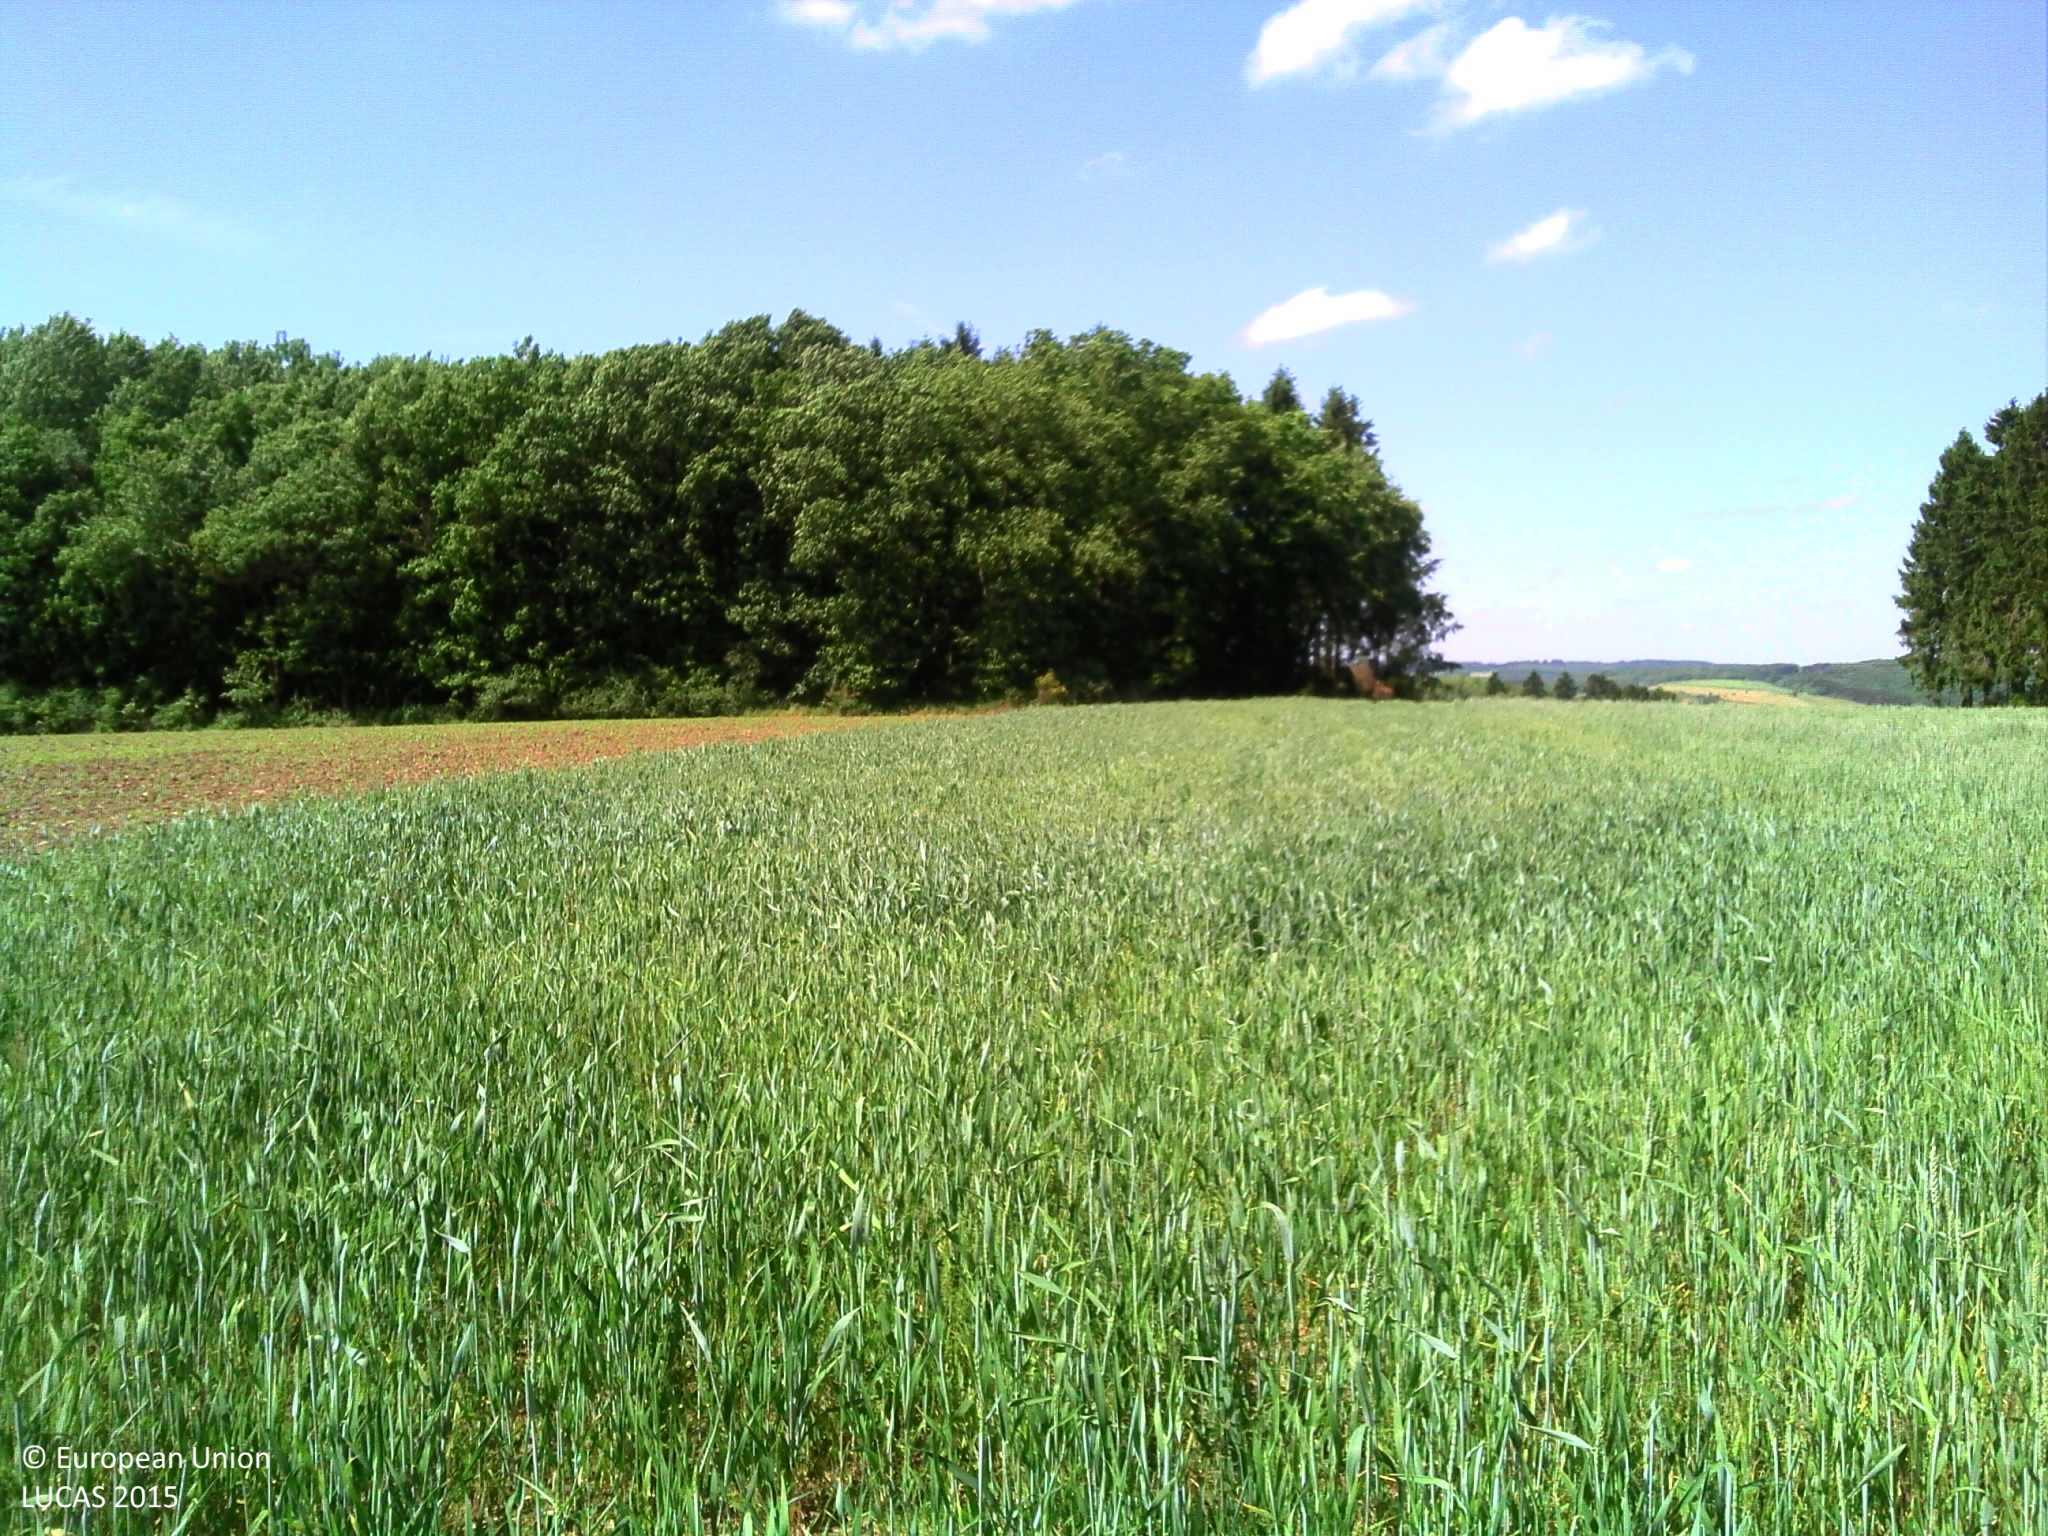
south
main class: Cropland
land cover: Common wheat
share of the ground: > 75 %
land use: Agriculture (excluding fallow land and kitchen gardens)
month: June
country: LU
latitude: 49.9091
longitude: 5.8075
